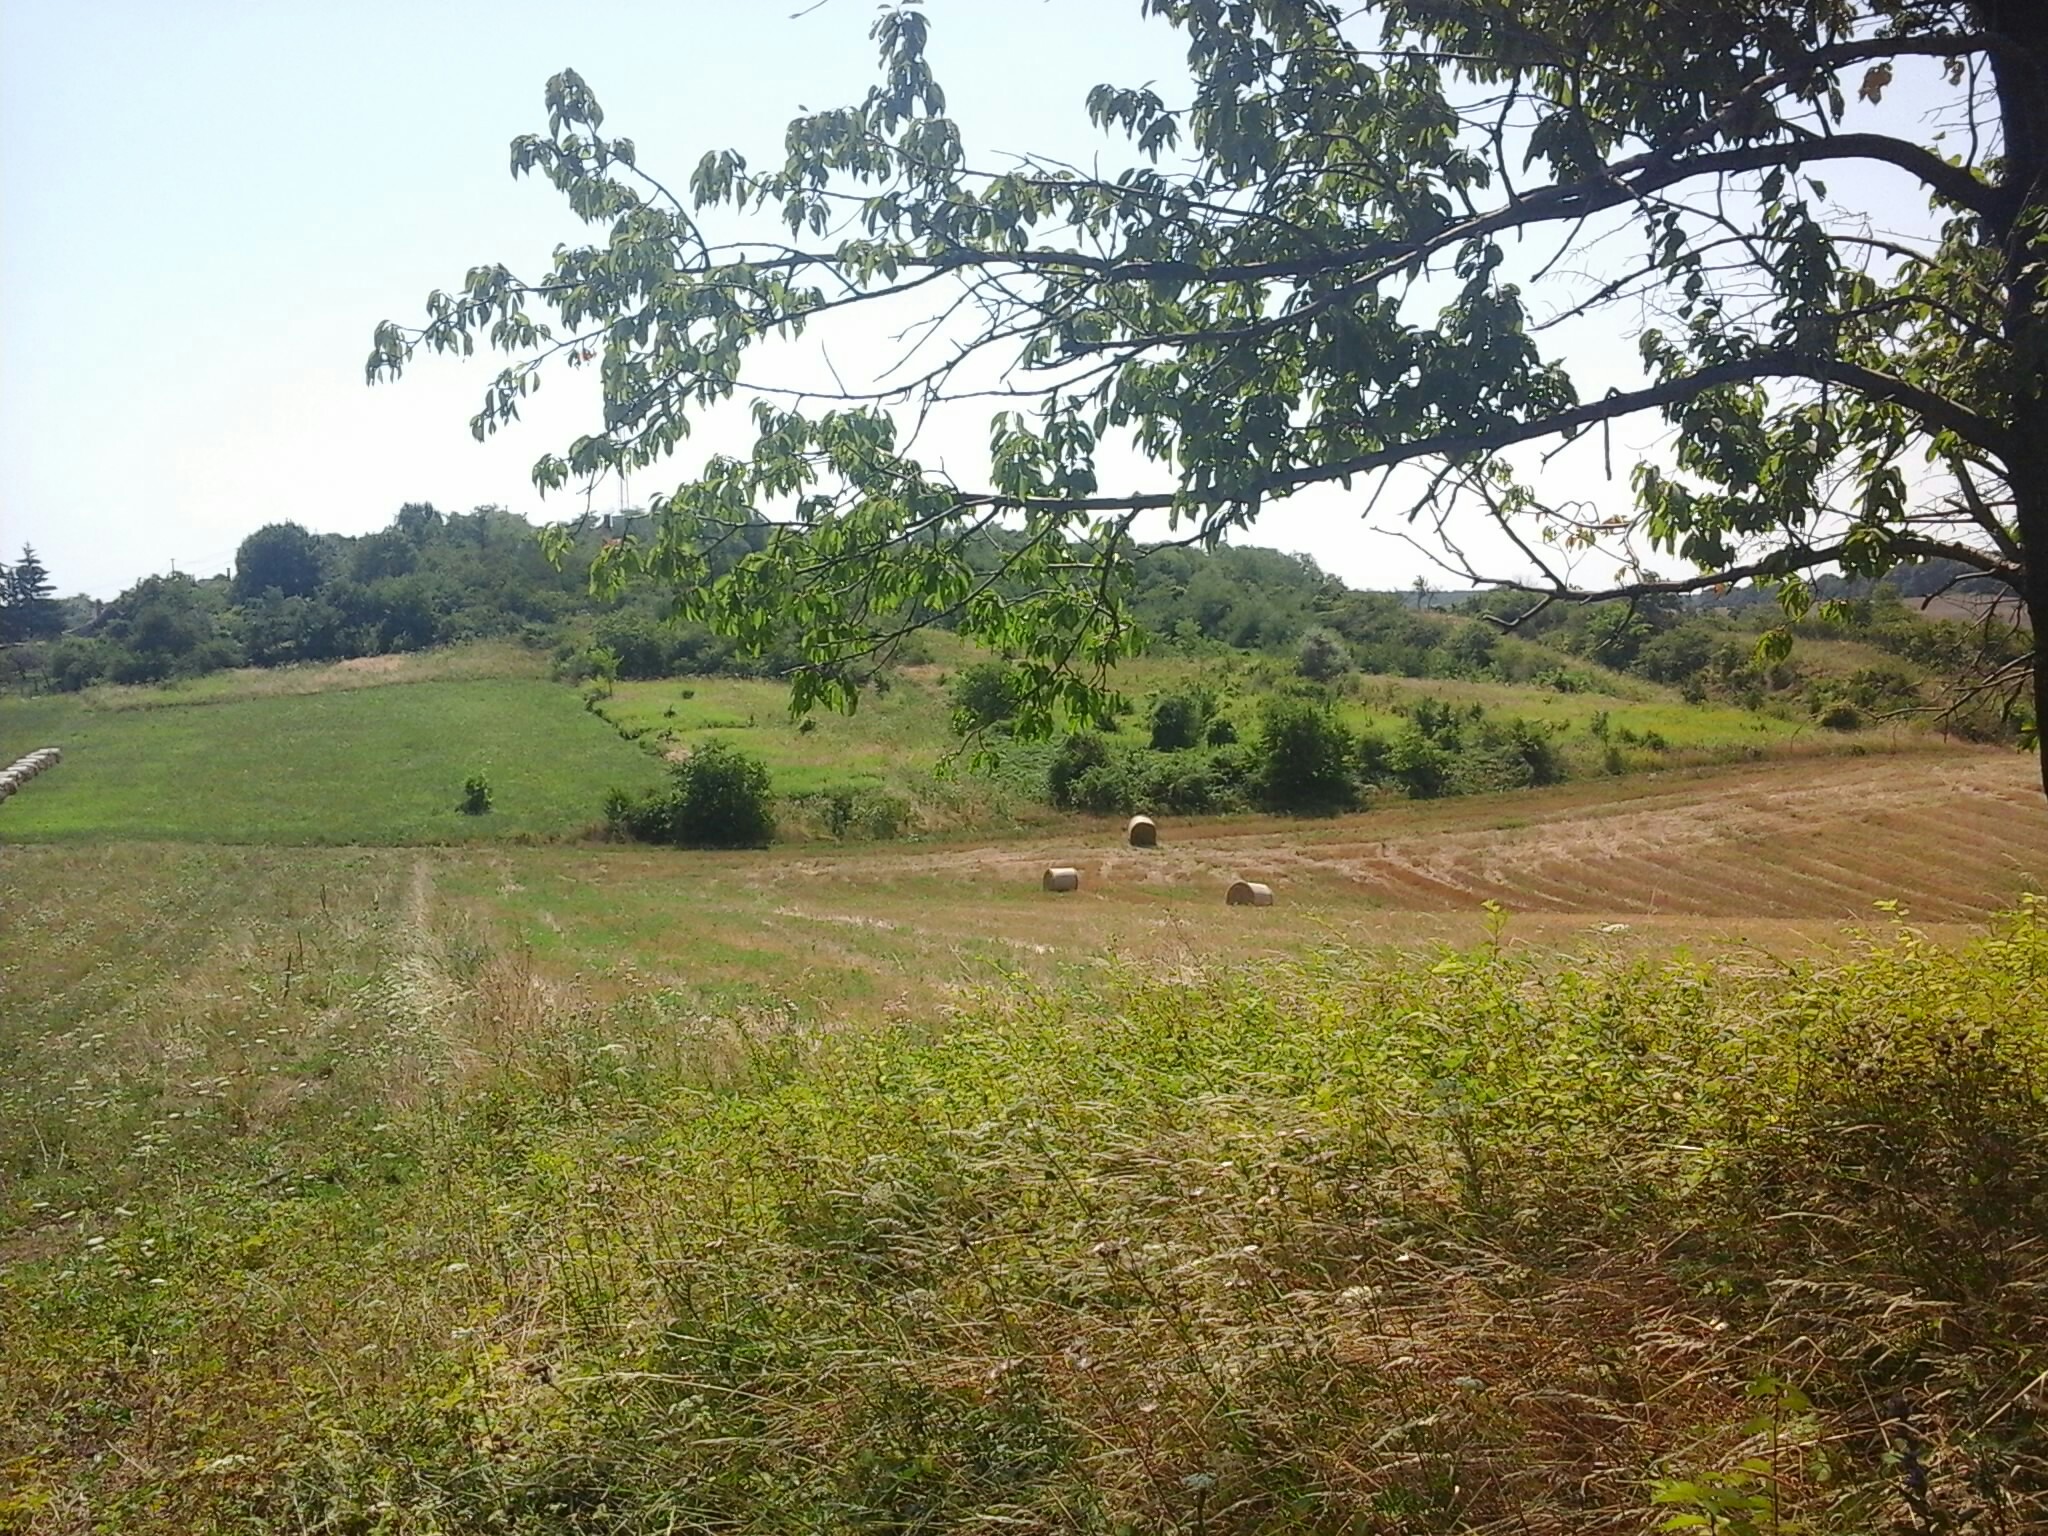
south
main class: Grassland
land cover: Grassland with sparse tree/shrub cover
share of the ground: > 75 %
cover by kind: herbaceous plants 85 %, shrubs 10 %, broadleaved forest trees 5 %
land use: Fallow land
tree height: > 5 m
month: August
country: HU
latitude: 47.4080
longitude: 18.0015
